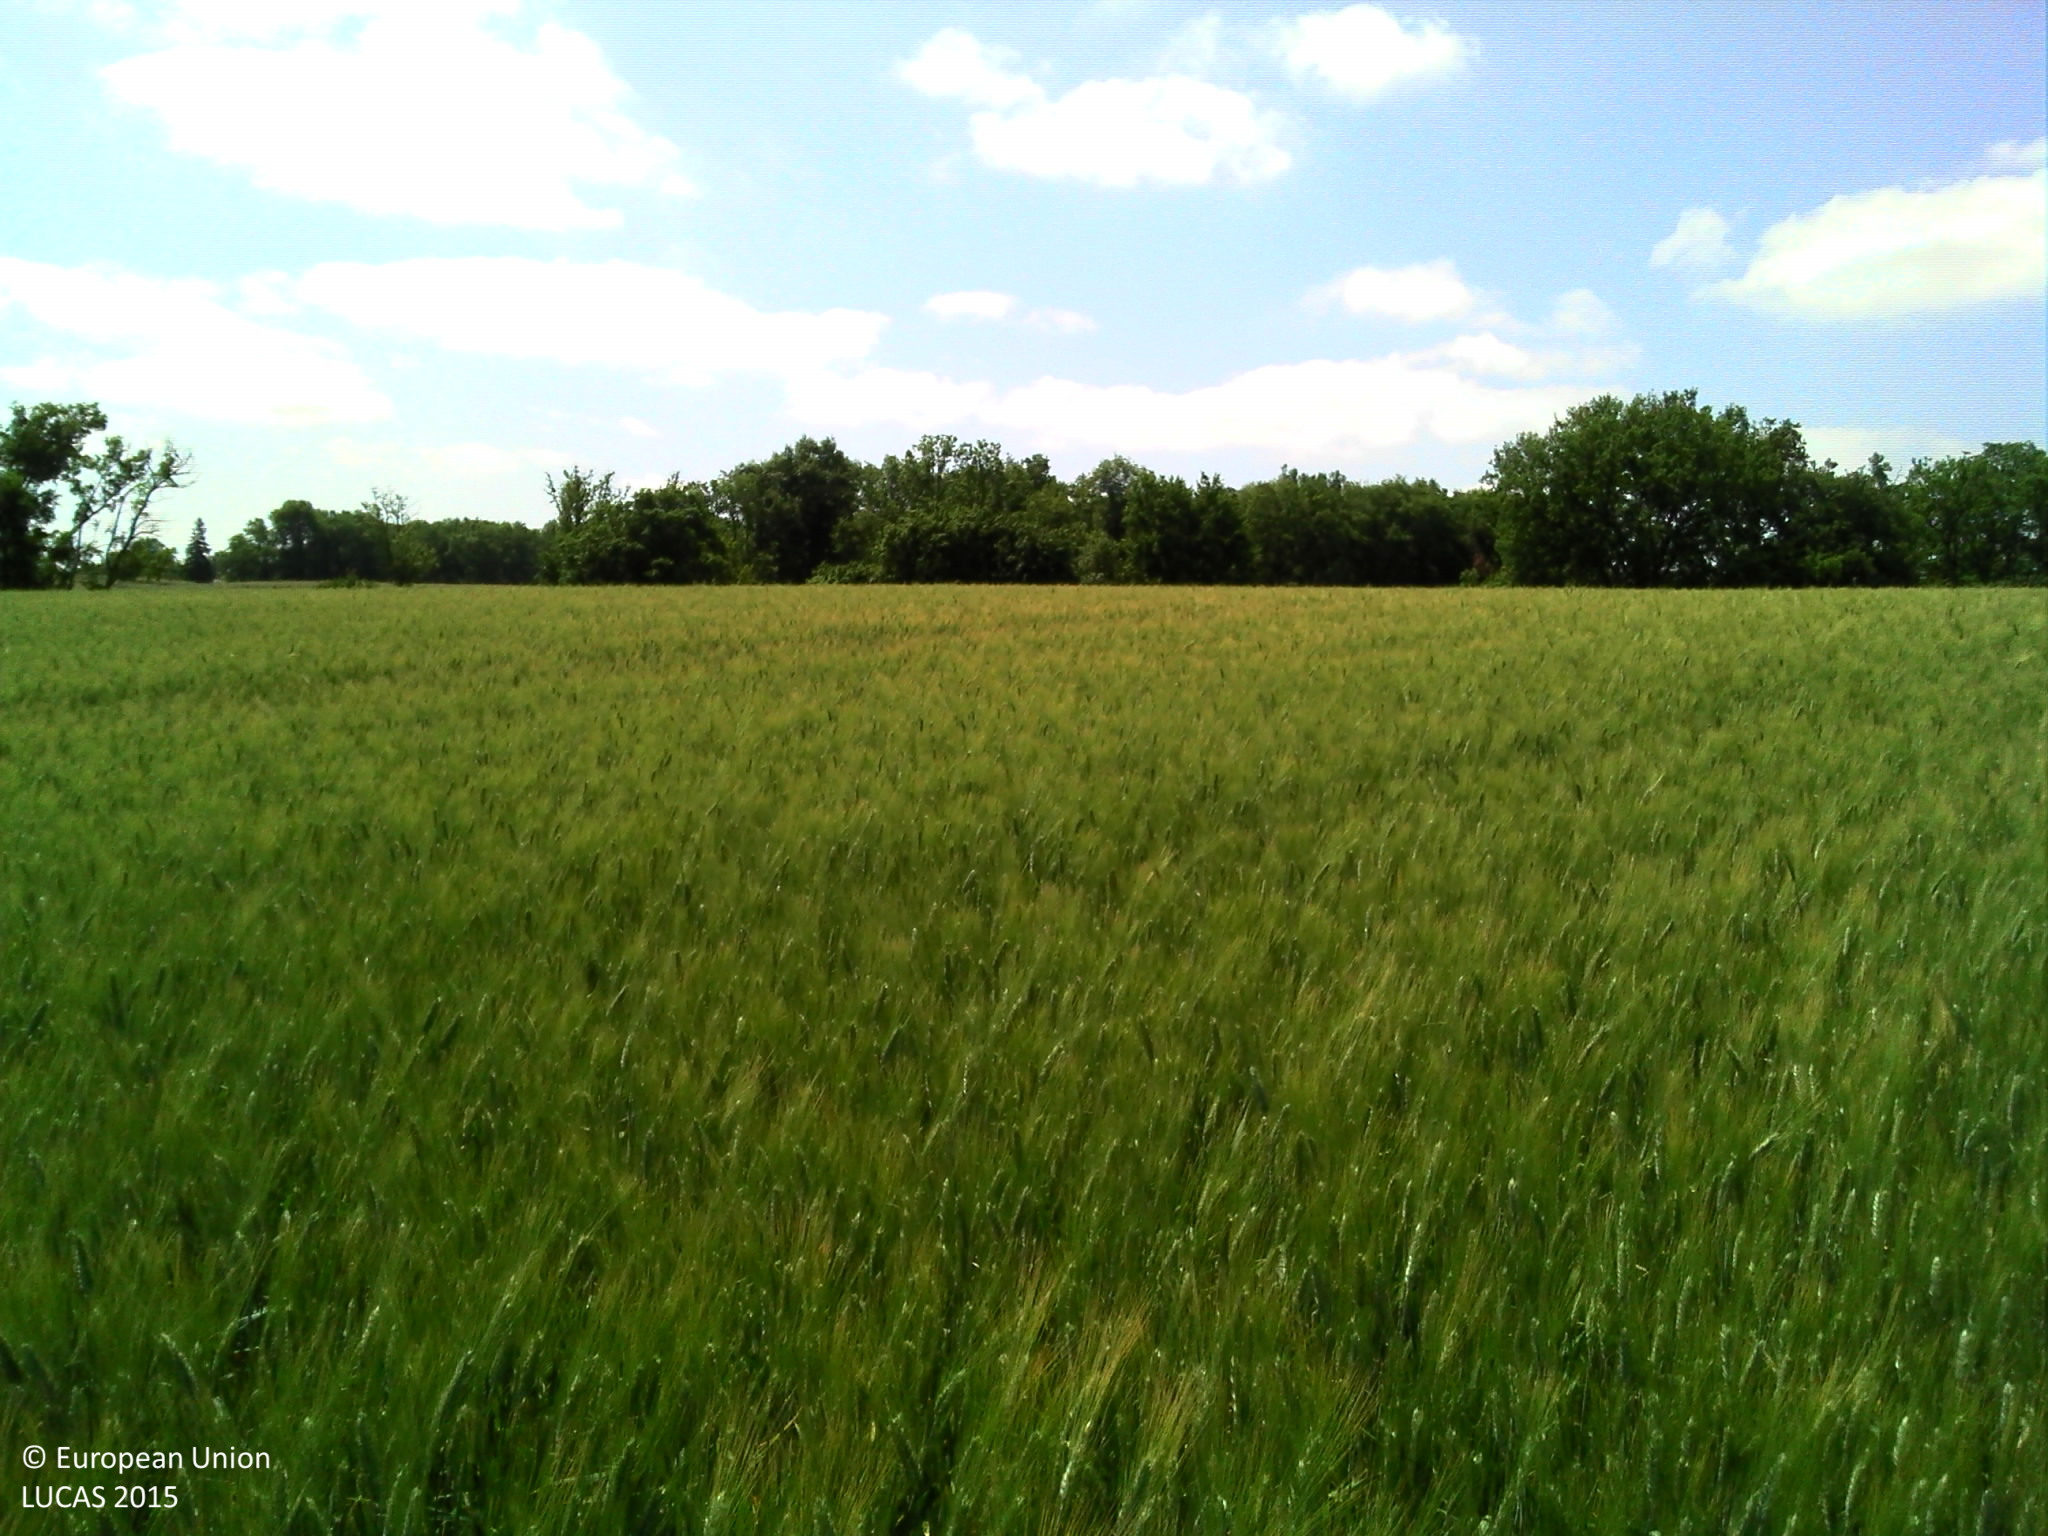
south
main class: Cropland
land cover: Durum wheat
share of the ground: > 75 %
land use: Agriculture (excluding fallow land and kitchen gardens)
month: June
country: FR
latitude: 43.6251
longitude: 0.7162
